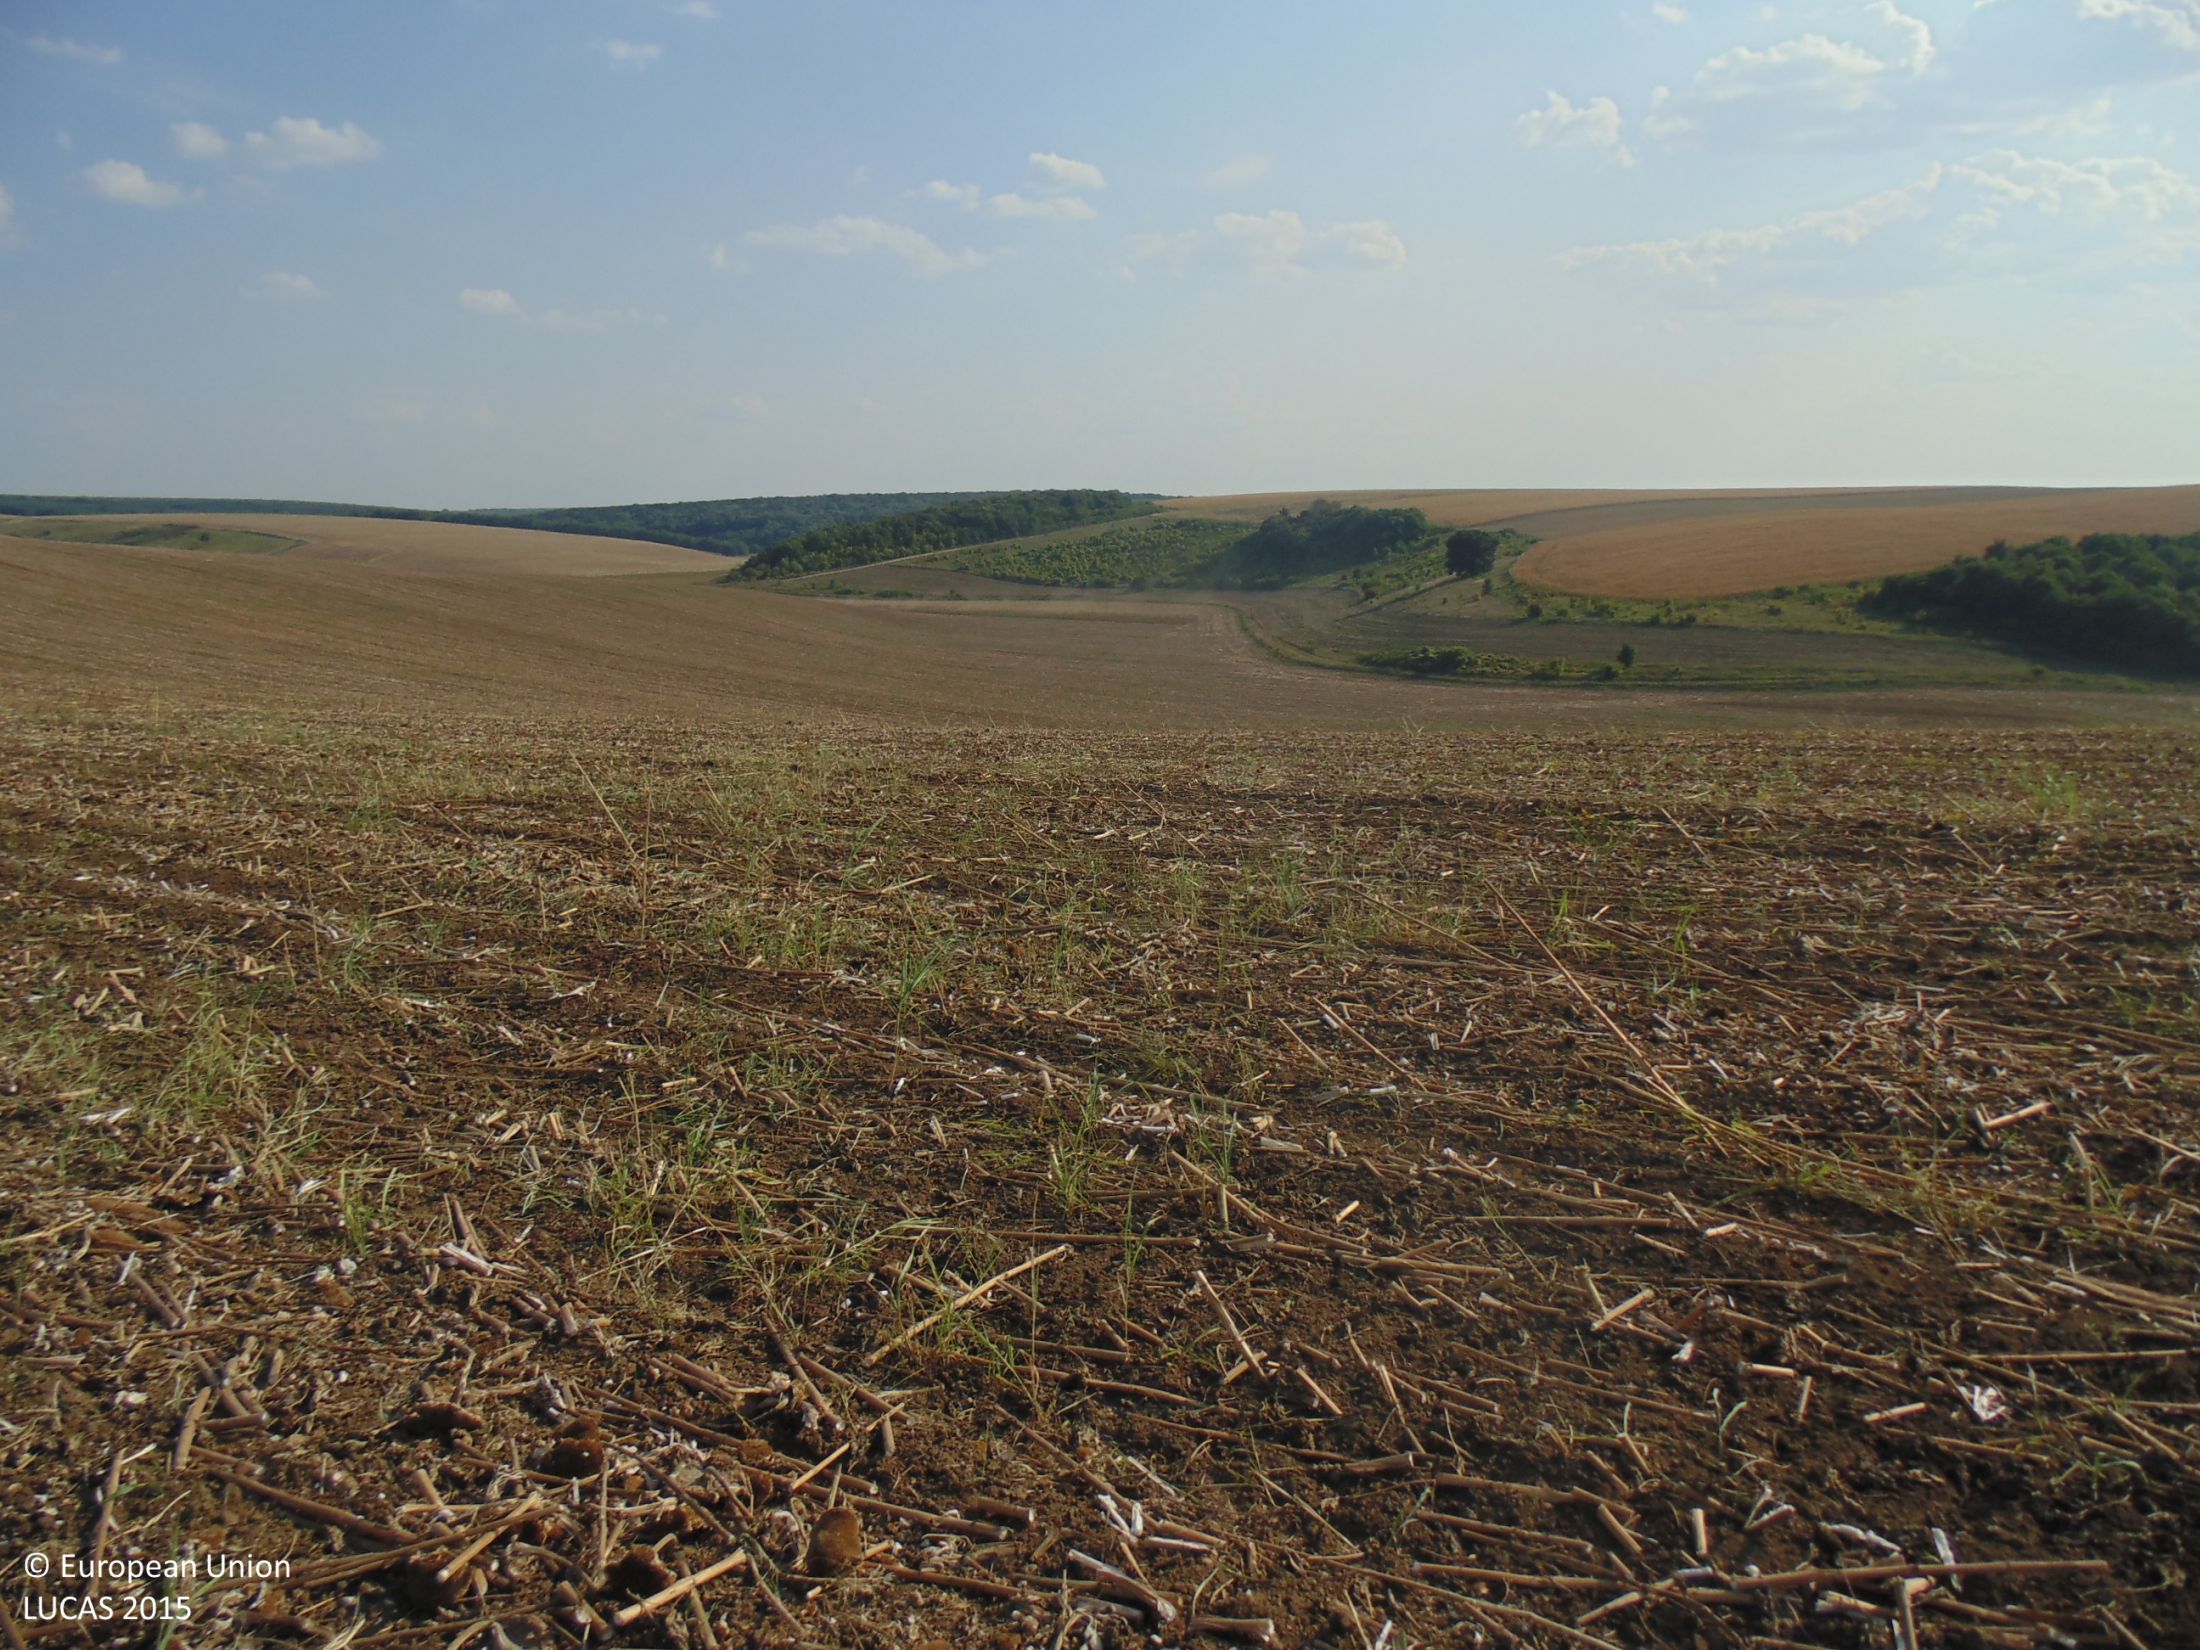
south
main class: Cropland
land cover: Sunflower
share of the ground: 10 - 25 %
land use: Agriculture (excluding fallow land and kitchen gardens)
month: August
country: BG
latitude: 43.9445
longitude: 27.2356
